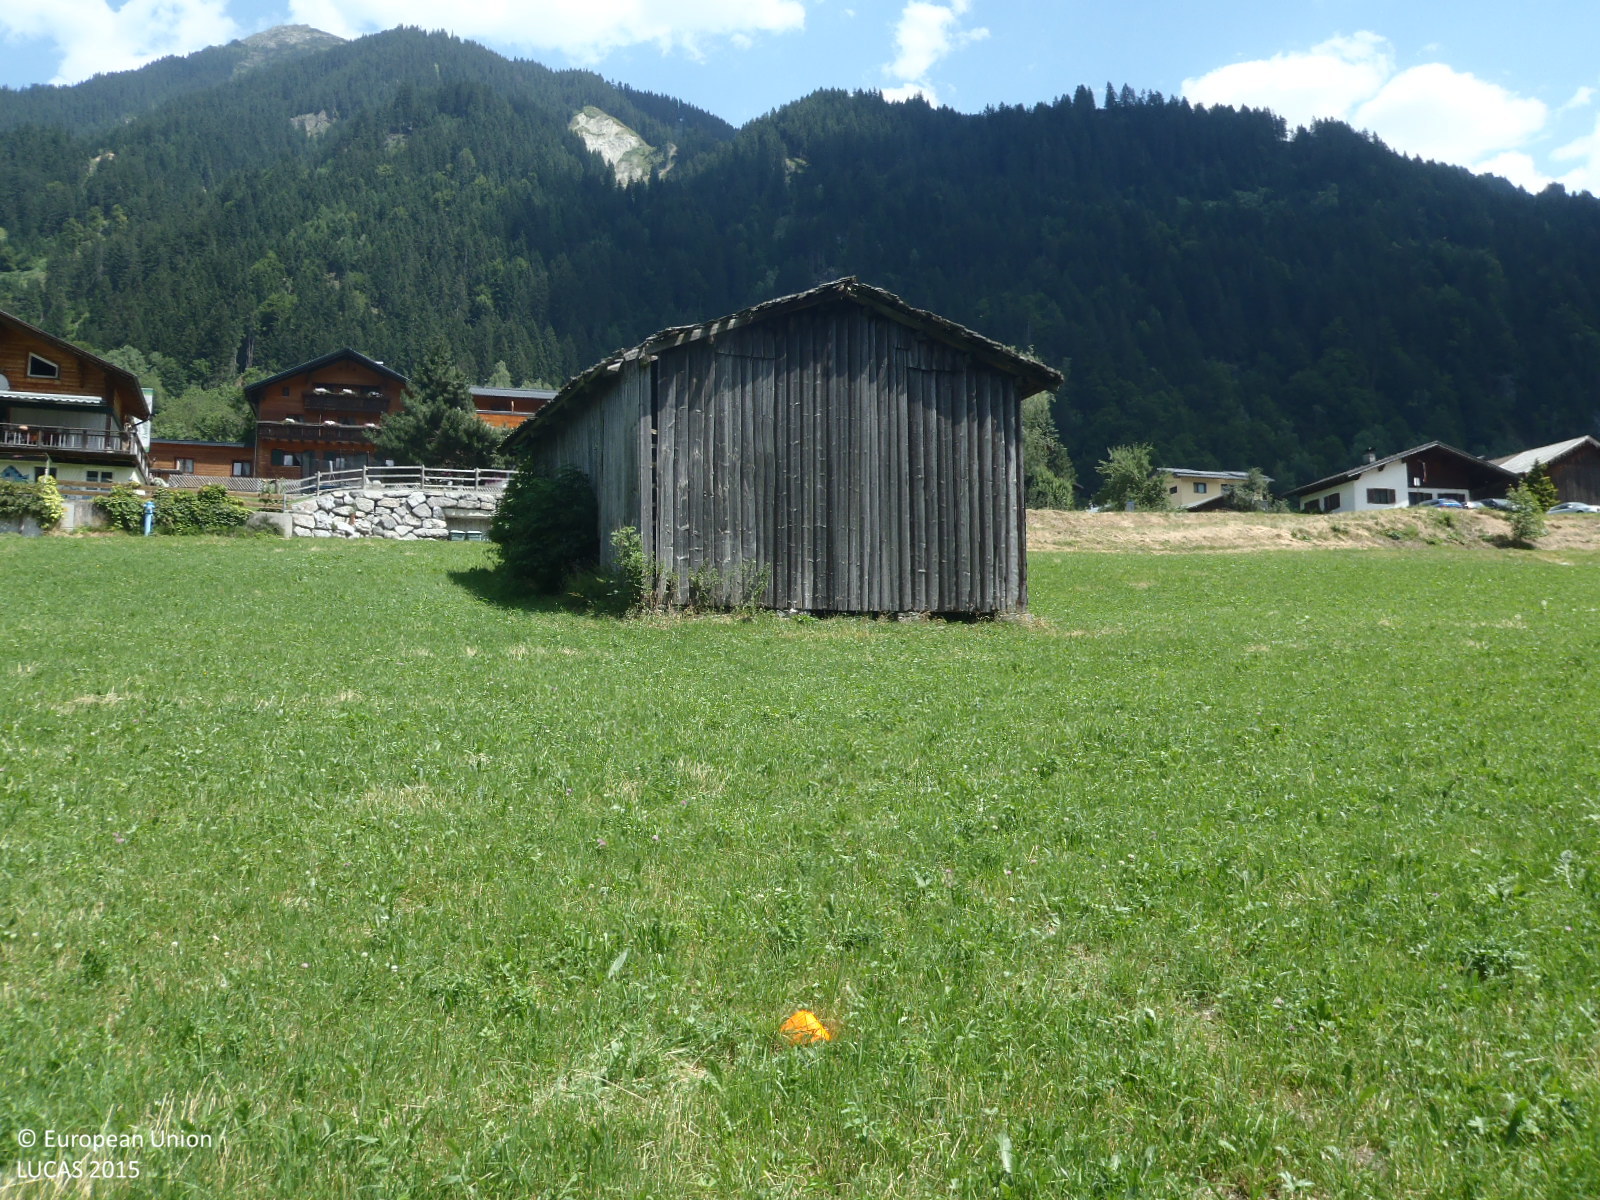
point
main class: Grassland
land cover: Grassland without tree/shrub cover
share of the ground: > 75 %
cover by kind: herbaceous plants 100 %
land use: Agriculture (excluding fallow land and kitchen gardens)
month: July
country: AT
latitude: 47.0175
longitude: 9.9869
